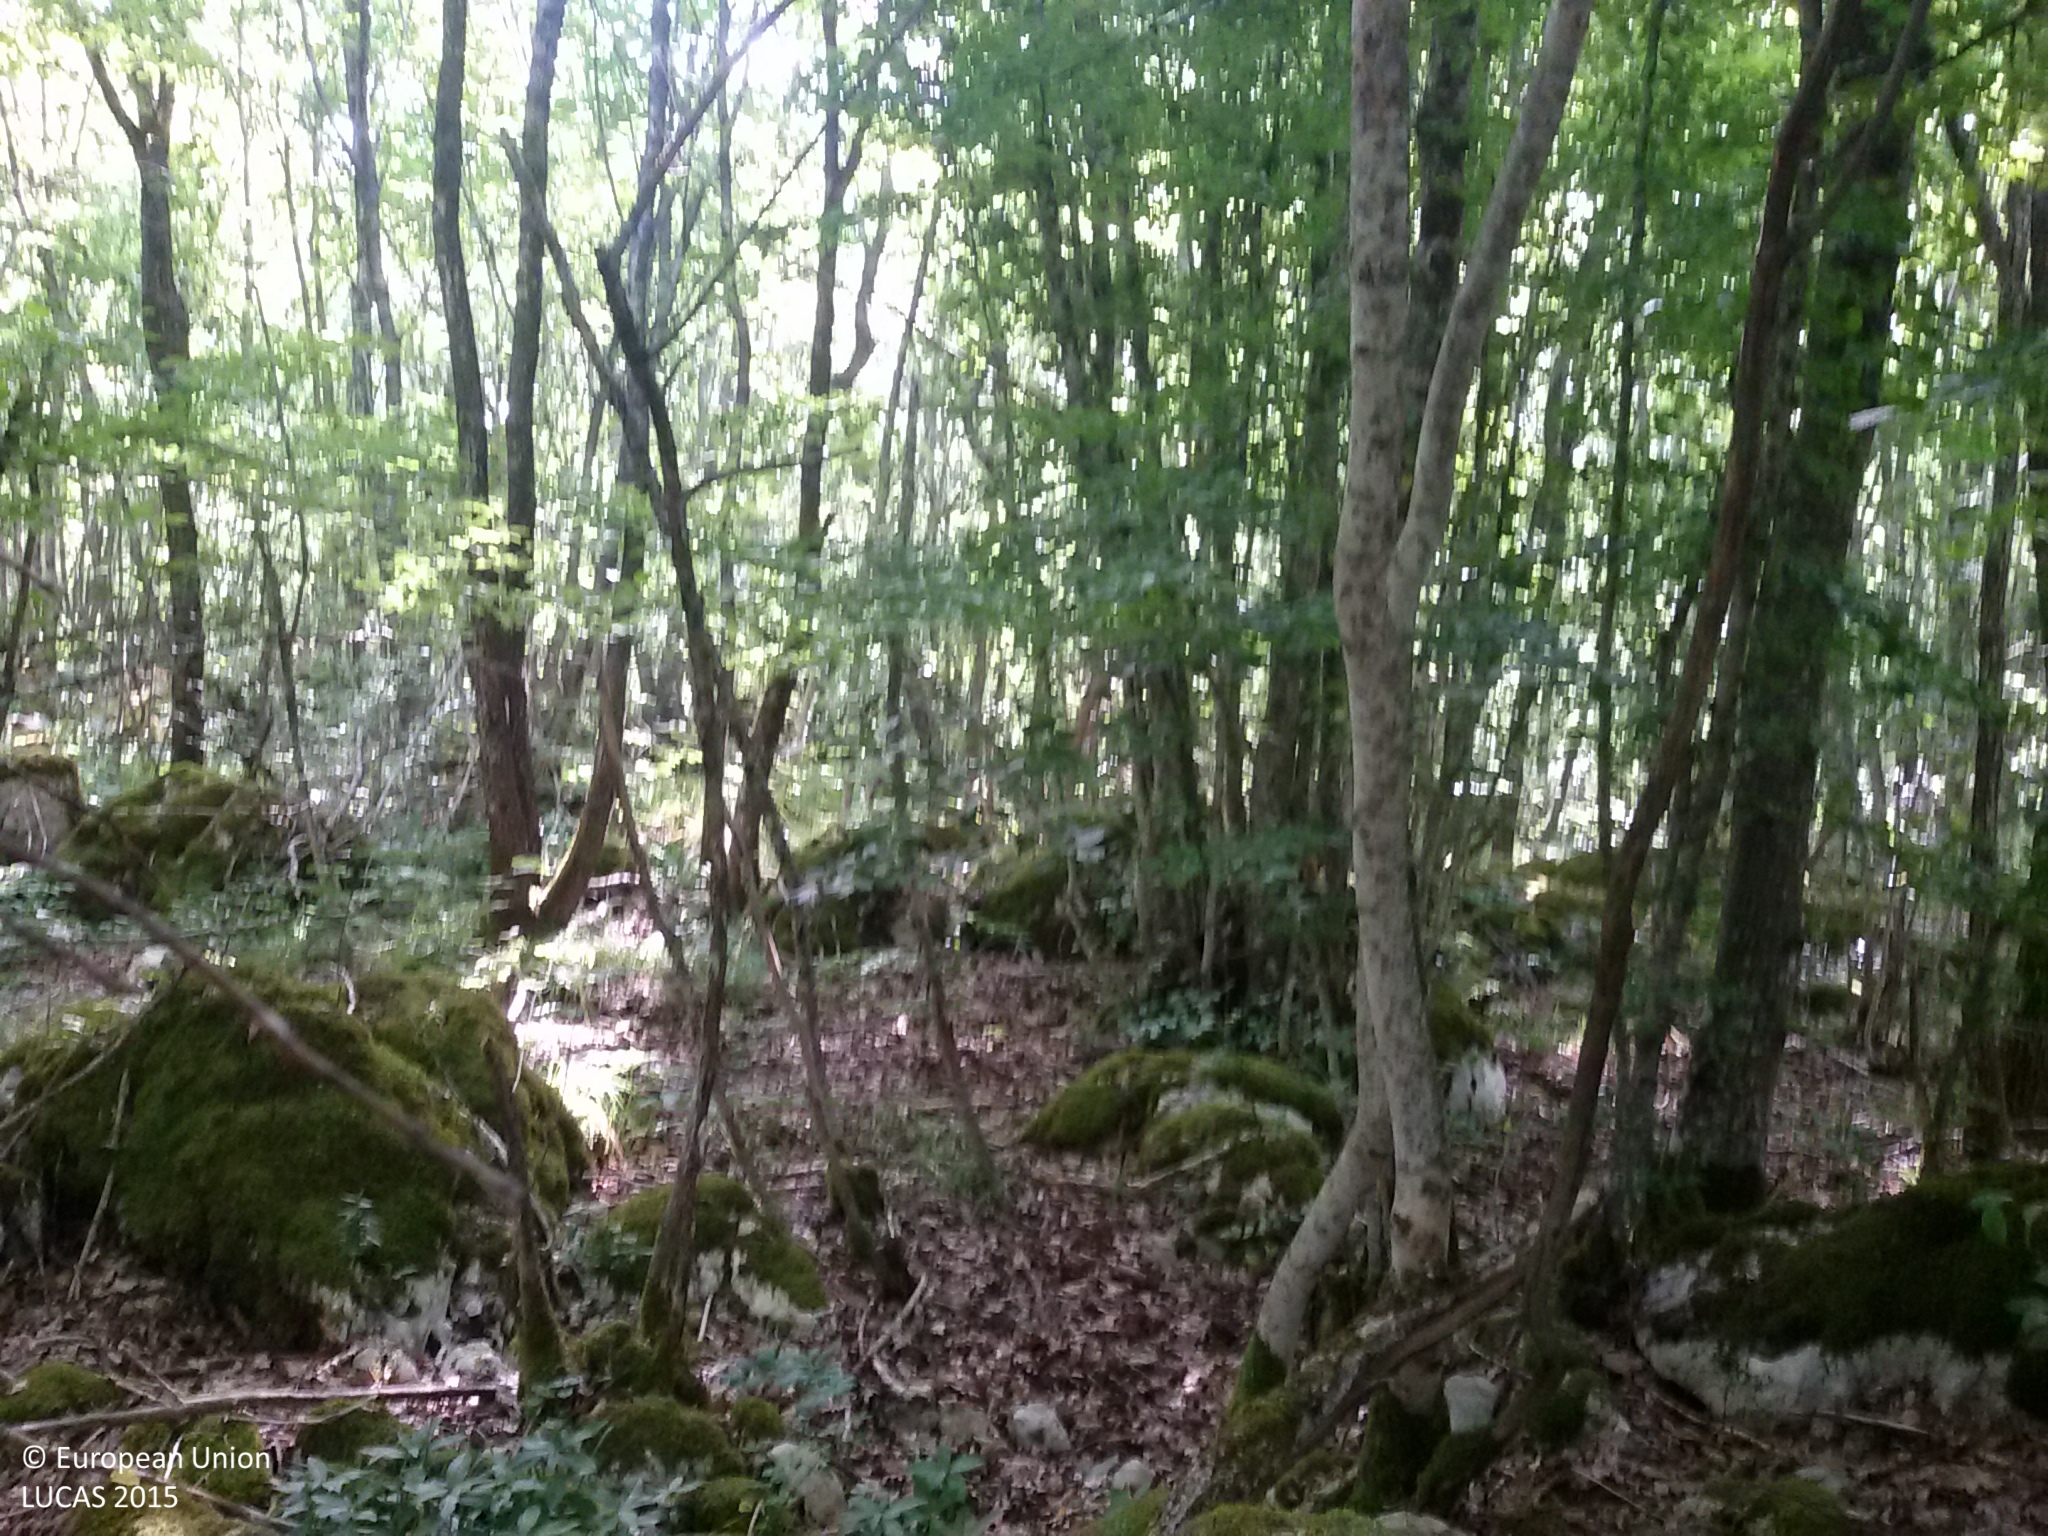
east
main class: Woodland
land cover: Broadleaved woodland
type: thermophilous deciduous forest
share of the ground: > 75 %
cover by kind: broadleaved forest trees 80 %, consolidated bare surface 10 %, lichens and mosses 5 %, unconsolidated bare surface 5 %
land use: Semi-natural and natural areas not in use
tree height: > 5 m
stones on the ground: < 10 %
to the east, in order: Broadleaved woodland; Grassland with sparse tree/shrub cover; Broadleaved woodland; Grassland with sparse tree/shrub cover; Broadleaved woodland; Grassland with sparse tree/shrub cover; Broadleaved woodland
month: June
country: HR
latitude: 44.5403
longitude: 15.6445
